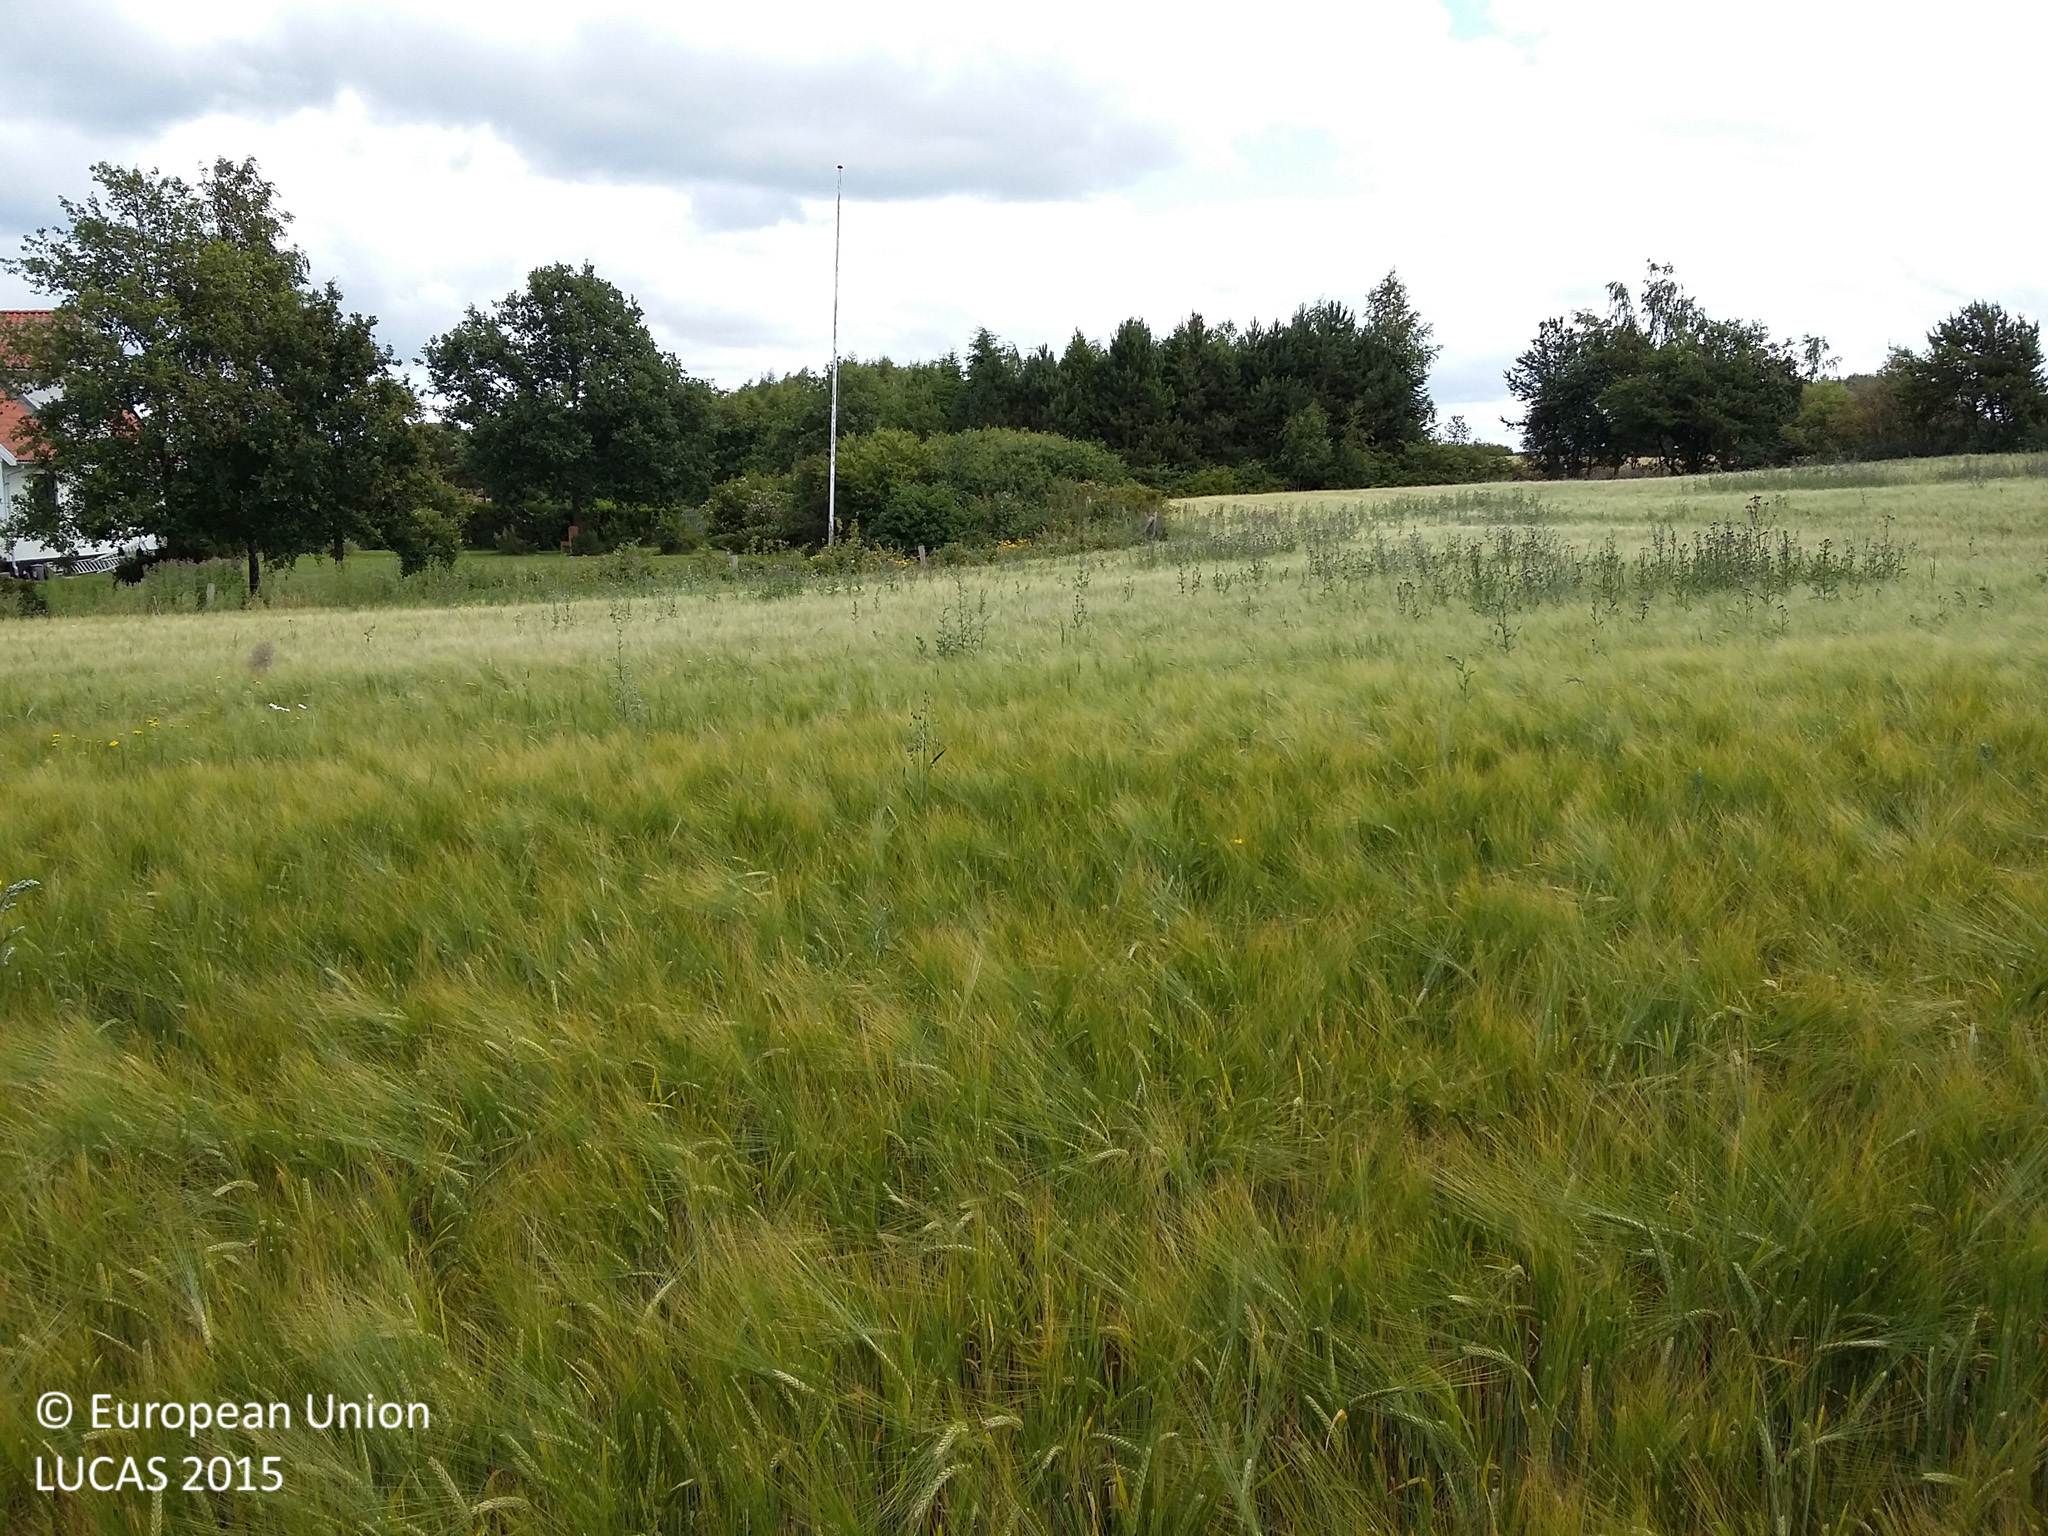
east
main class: Cropland
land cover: Barley
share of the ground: > 75 %
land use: Agriculture (excluding fallow land and kitchen gardens)
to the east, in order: Grass margins; Barley; Fences; Grassland without tree/shrub cover; Broadleaved woodland; Fences; Tracks; Broadleaved woodland; Spruce dominated coniferous woodland; Tracks; Pine dominated mixed woodland; Rye
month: July
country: DK
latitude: 55.9886
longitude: 12.2261
